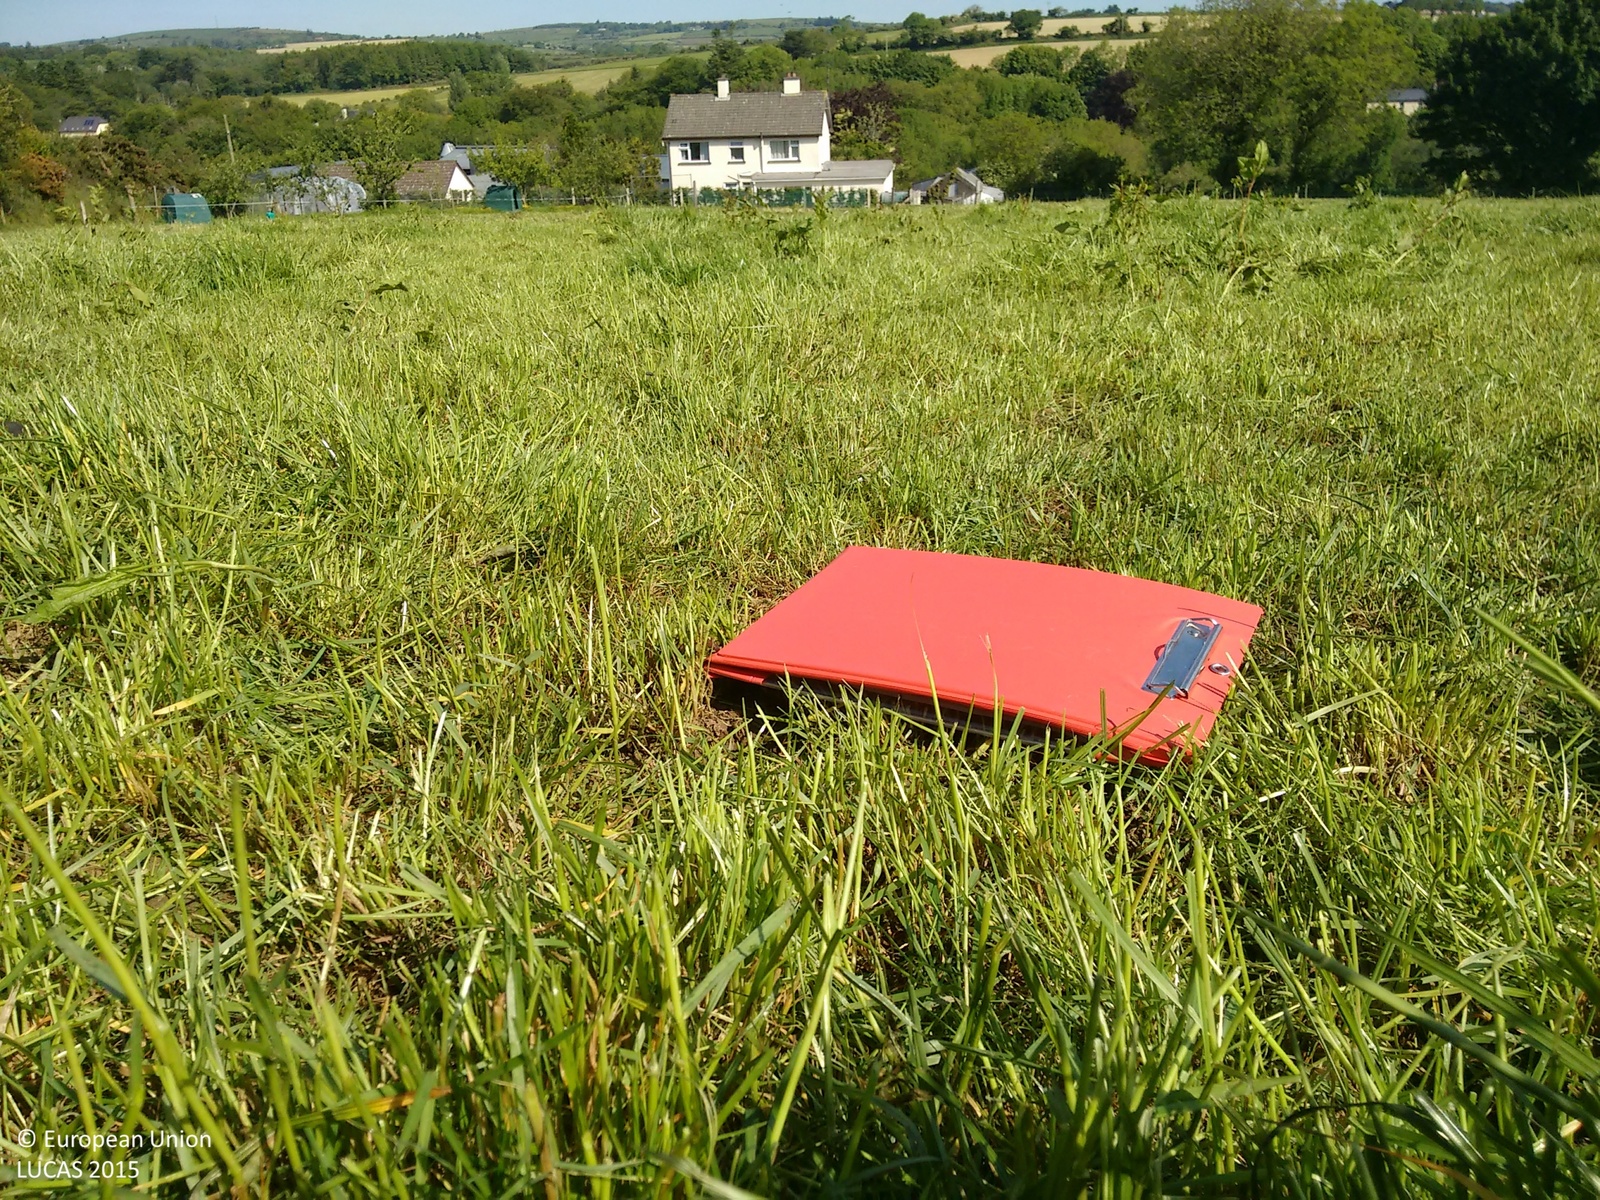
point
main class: Grassland
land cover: Grassland without tree/shrub cover
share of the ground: > 75 %
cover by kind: herbaceous plants 100 %
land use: Agriculture (excluding fallow land and kitchen gardens)
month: June
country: IE
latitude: 51.7837
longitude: -8.7735
